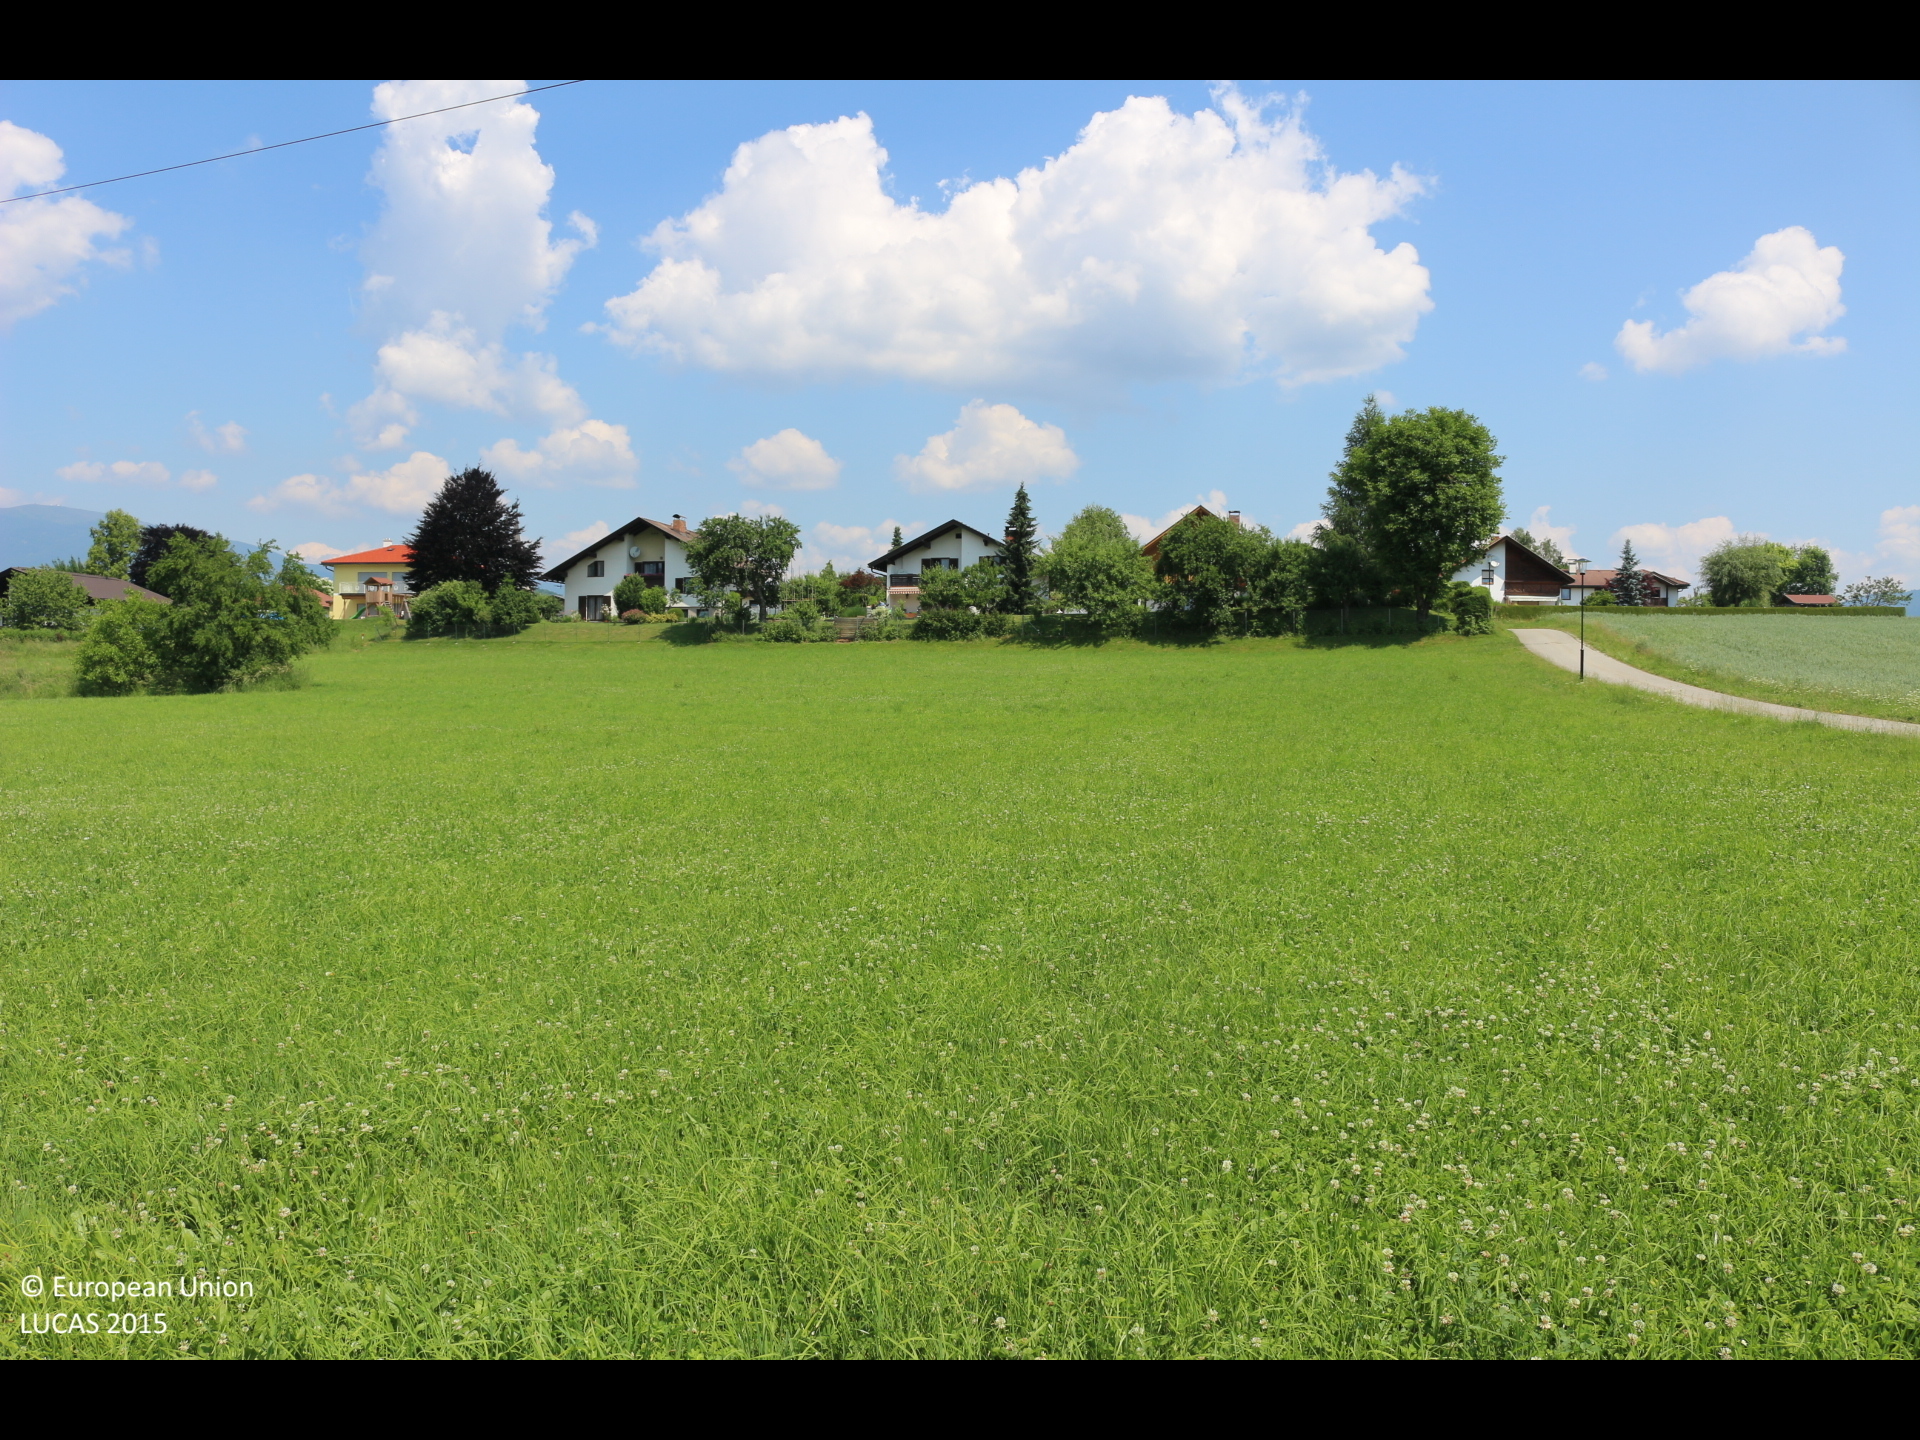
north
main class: Grassland
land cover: Grassland without tree/shrub cover
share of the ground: > 75 %
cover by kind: herbaceous plants 100 %
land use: Agriculture (excluding fallow land and kitchen gardens)
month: June
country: AT
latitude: 46.6008
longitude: 14.0049
